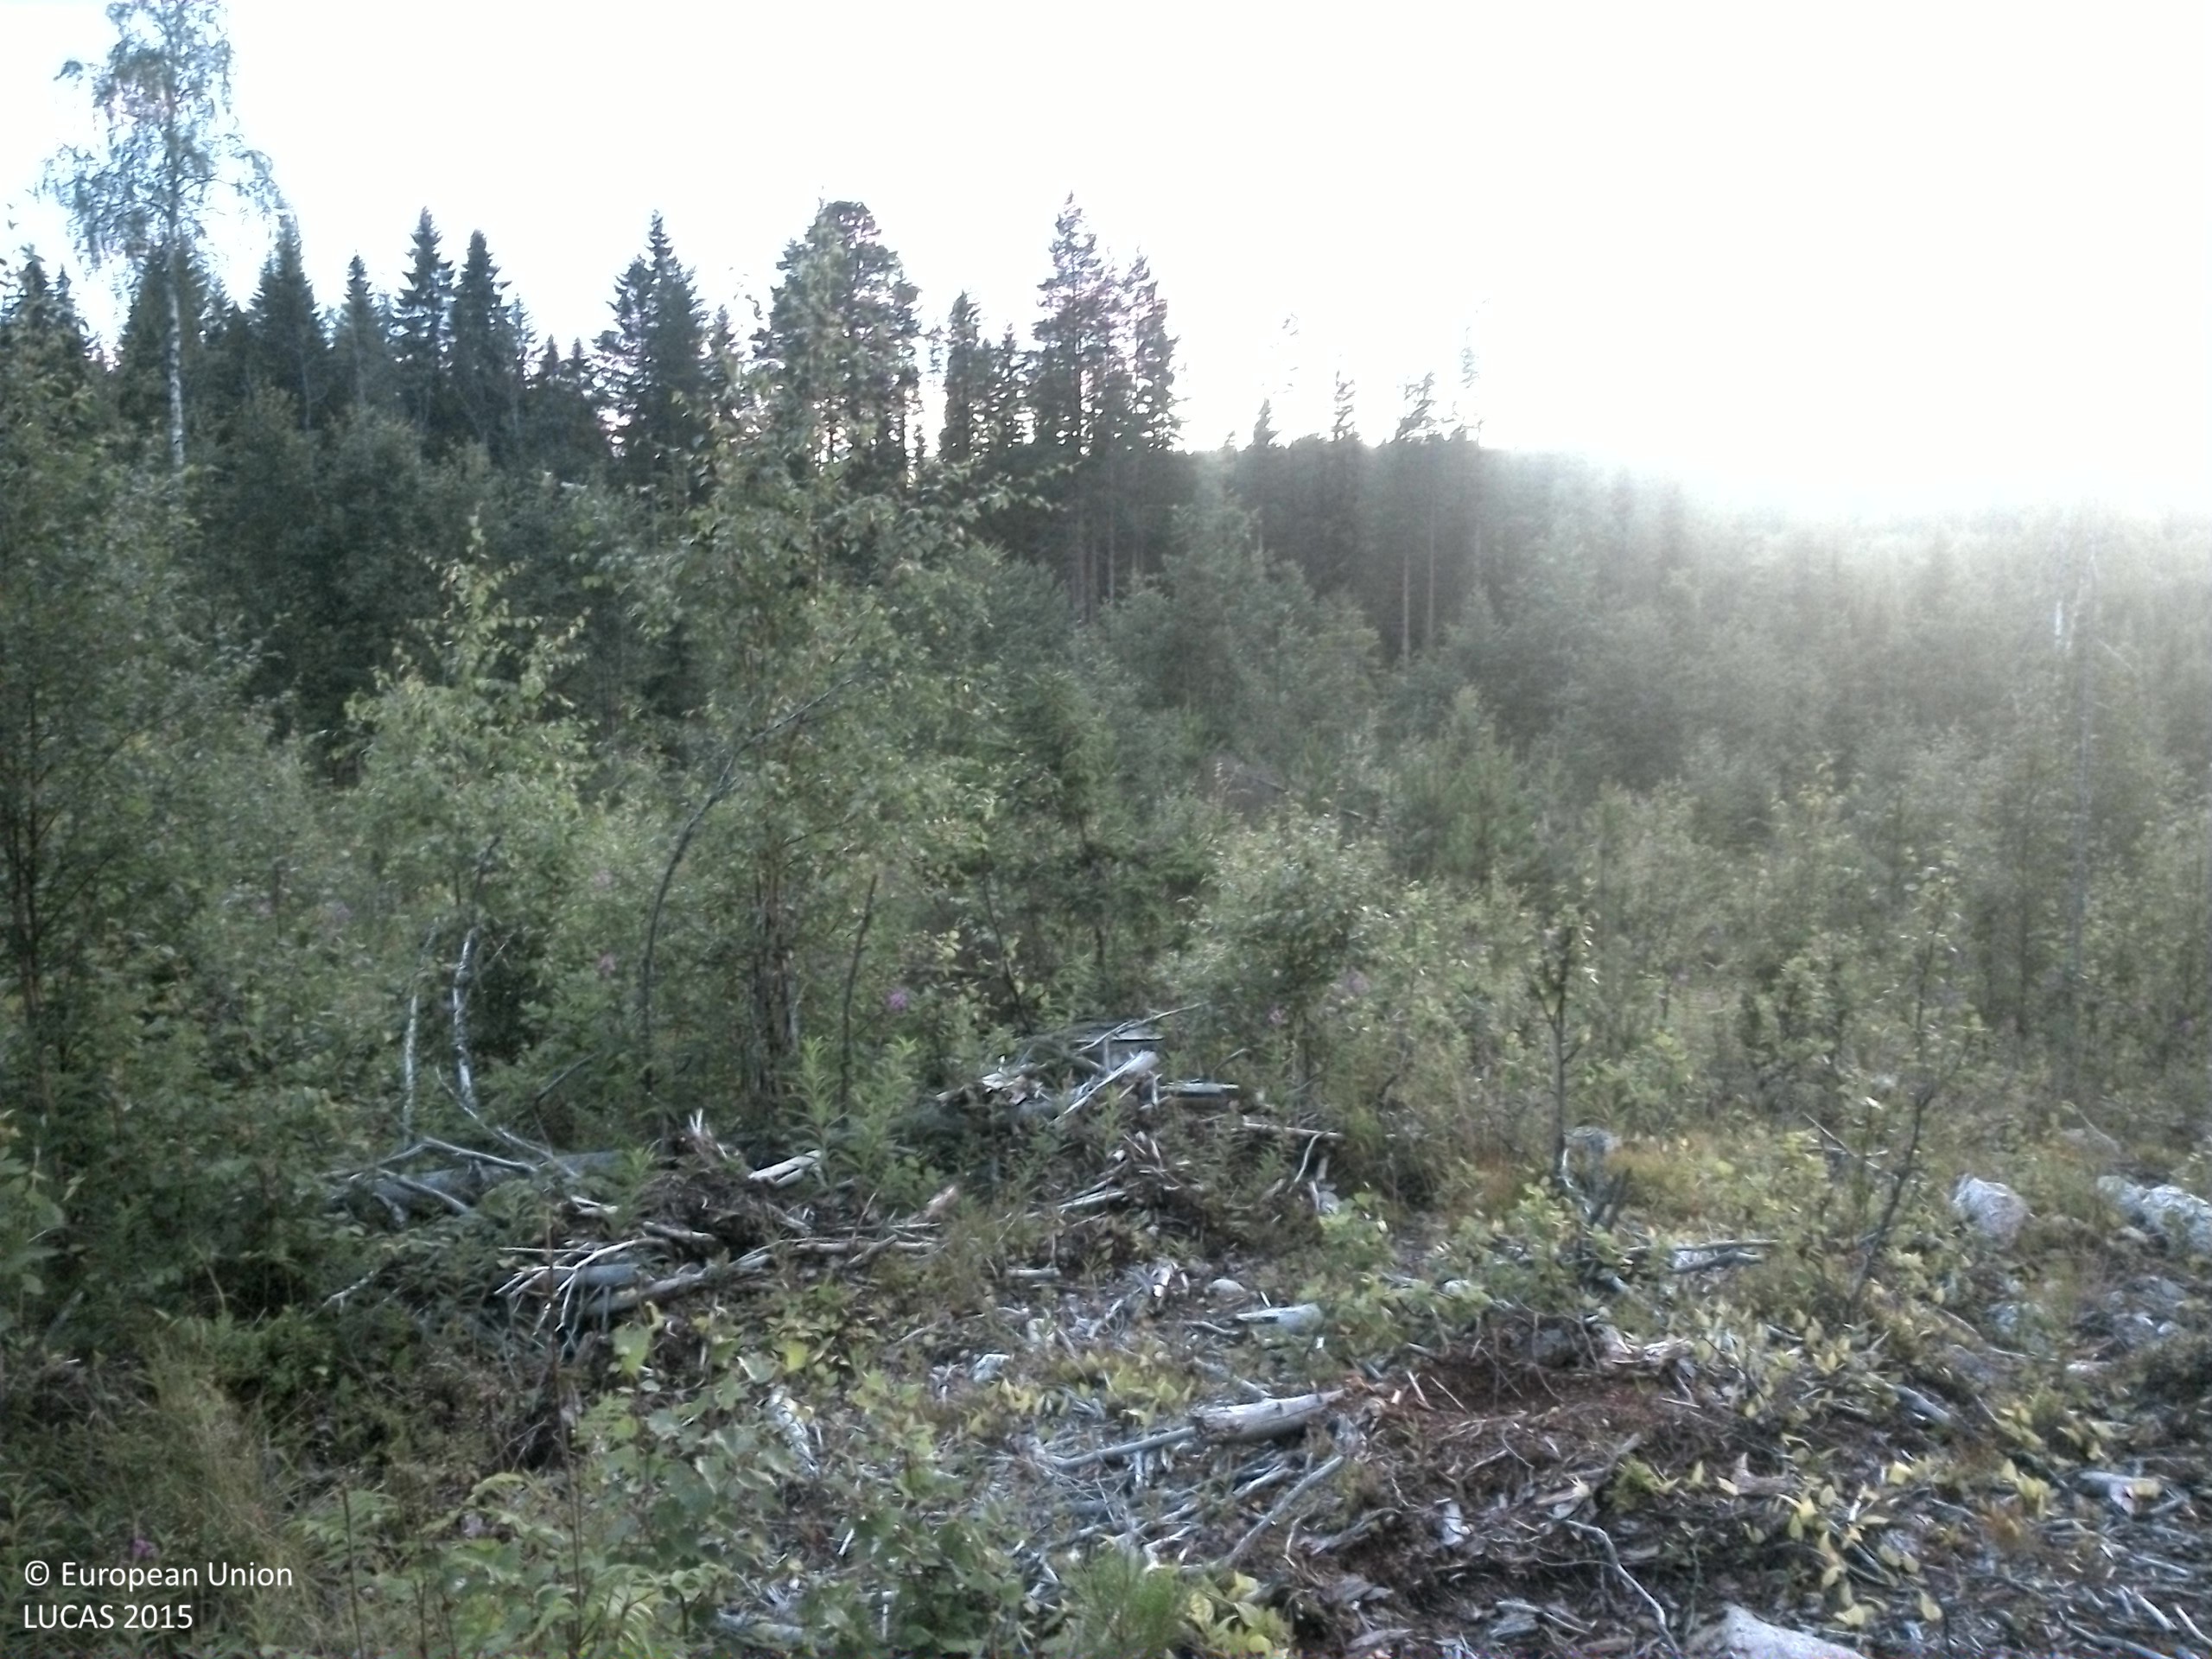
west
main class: Woodland
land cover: Broadleaved woodland
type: boreal forest
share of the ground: 25 - 50 %
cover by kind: herbaceous plants 40 %, broadleaved forest trees 30 %, shrubs 10 %, lichens and mosses 10 %, coniferous forest trees 5 %, unconsolidated bare surface 5 %
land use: Forestry
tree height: < 5 m
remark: Clear cut
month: August
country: SE
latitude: 63.5708
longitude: 16.1962
